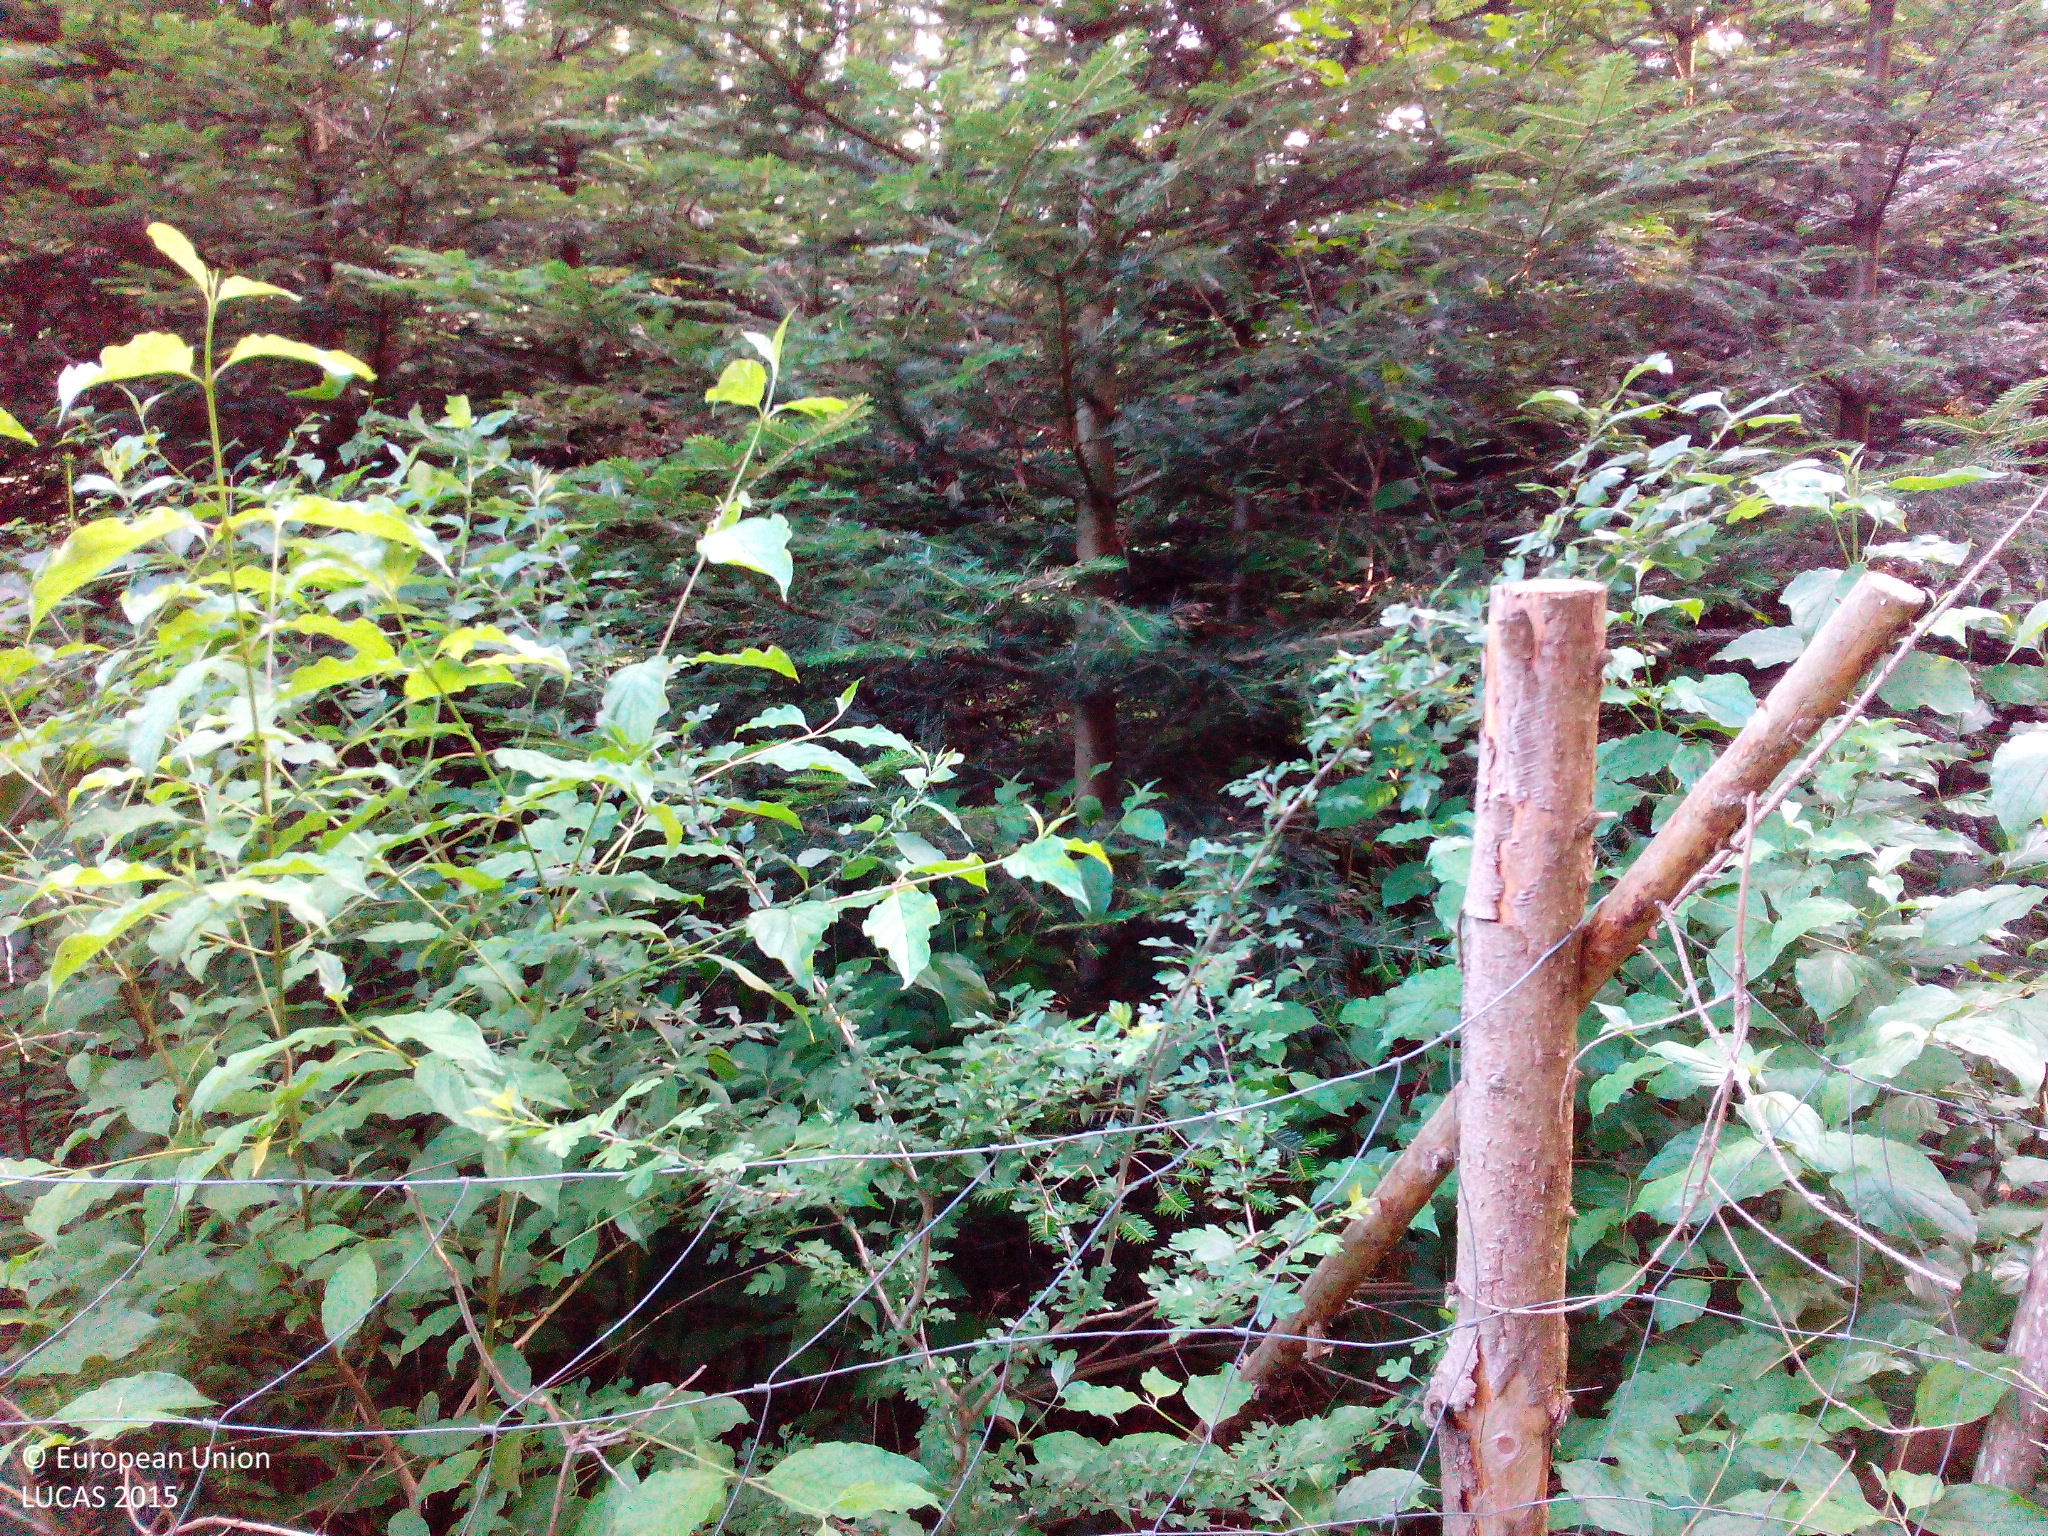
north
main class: Woodland
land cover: Spruce dominated coniferous woodland
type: hemiboreal forest and nemoral coniferous forest and mixed broadleaved-coniferous forest
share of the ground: > 75 %
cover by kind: coniferous forest trees 85 %, shrubs 15 %
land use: Forestry
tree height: > 5 m
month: July
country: DE
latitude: 48.9037
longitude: 10.8864
